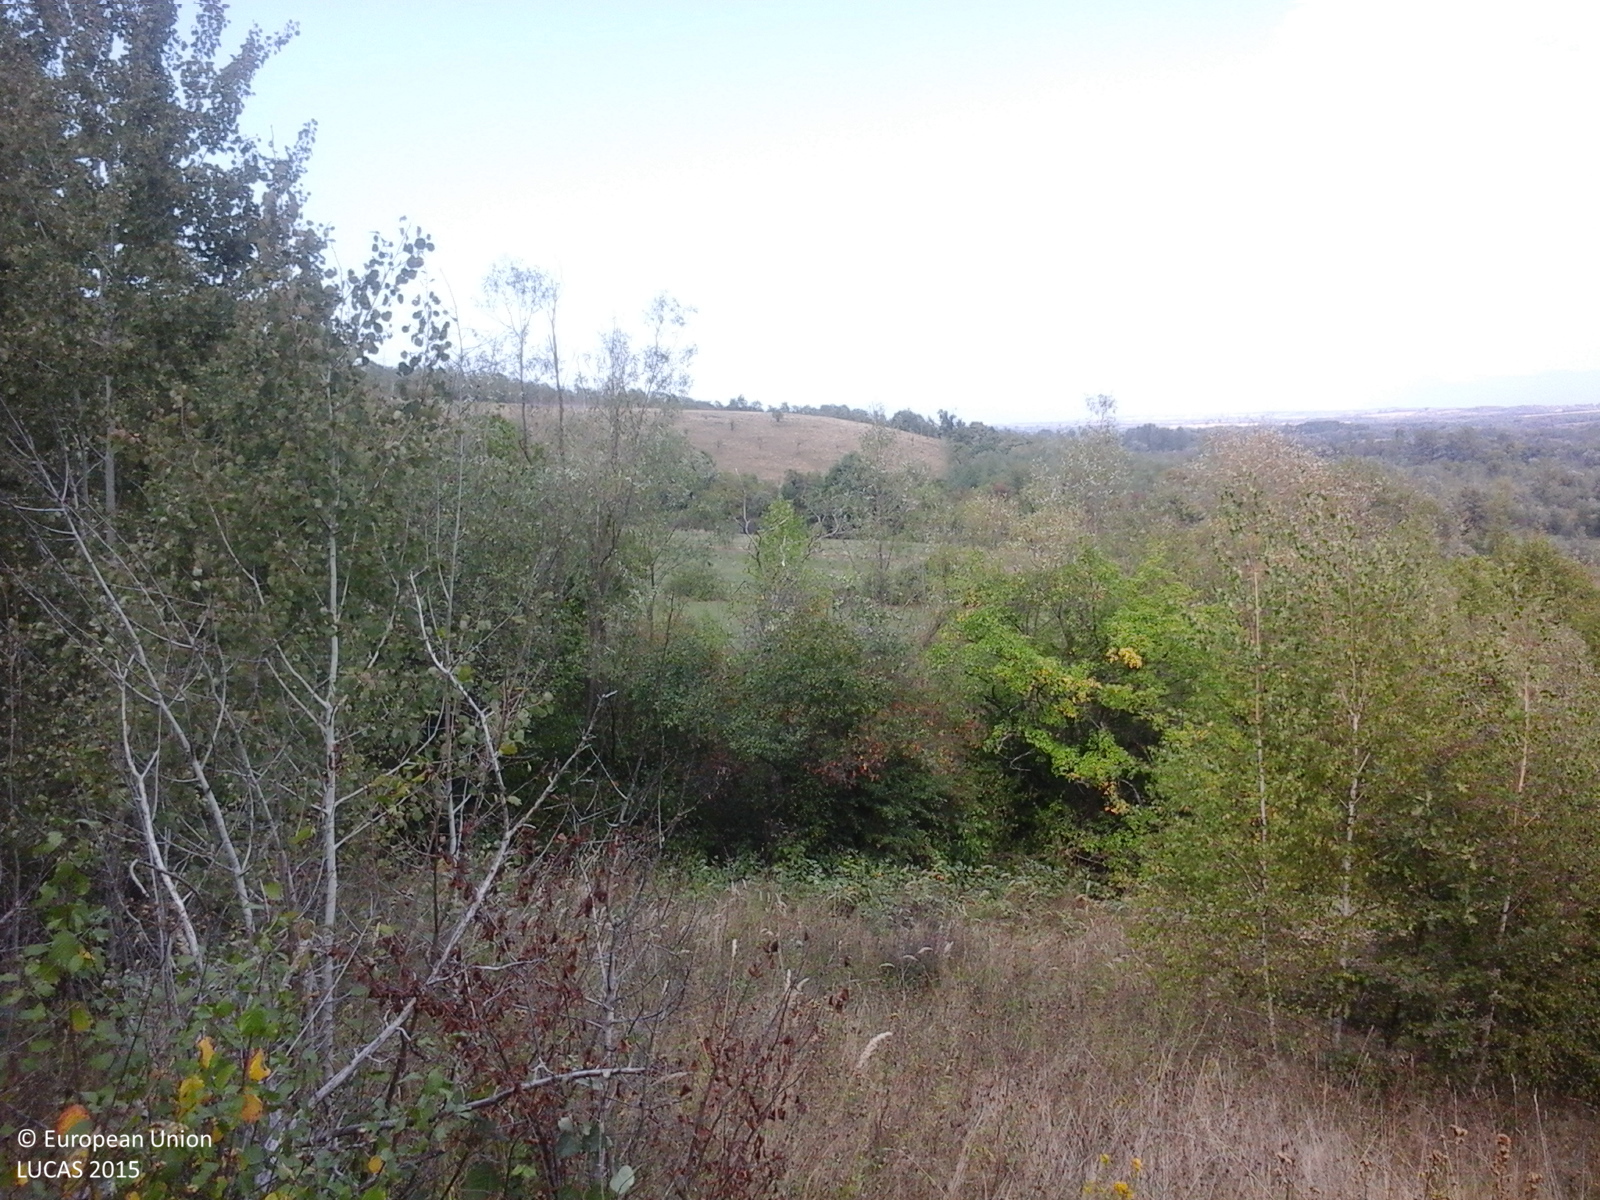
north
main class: Grassland
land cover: Grassland with sparse tree/shrub cover
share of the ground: > 75 %
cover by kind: herbaceous plants 85 %, shrubs 10 %, broadleaved forest trees 5 %
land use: Fallow land
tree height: < 5 m
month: September
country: RO
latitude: 45.3342
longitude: 22.2524
